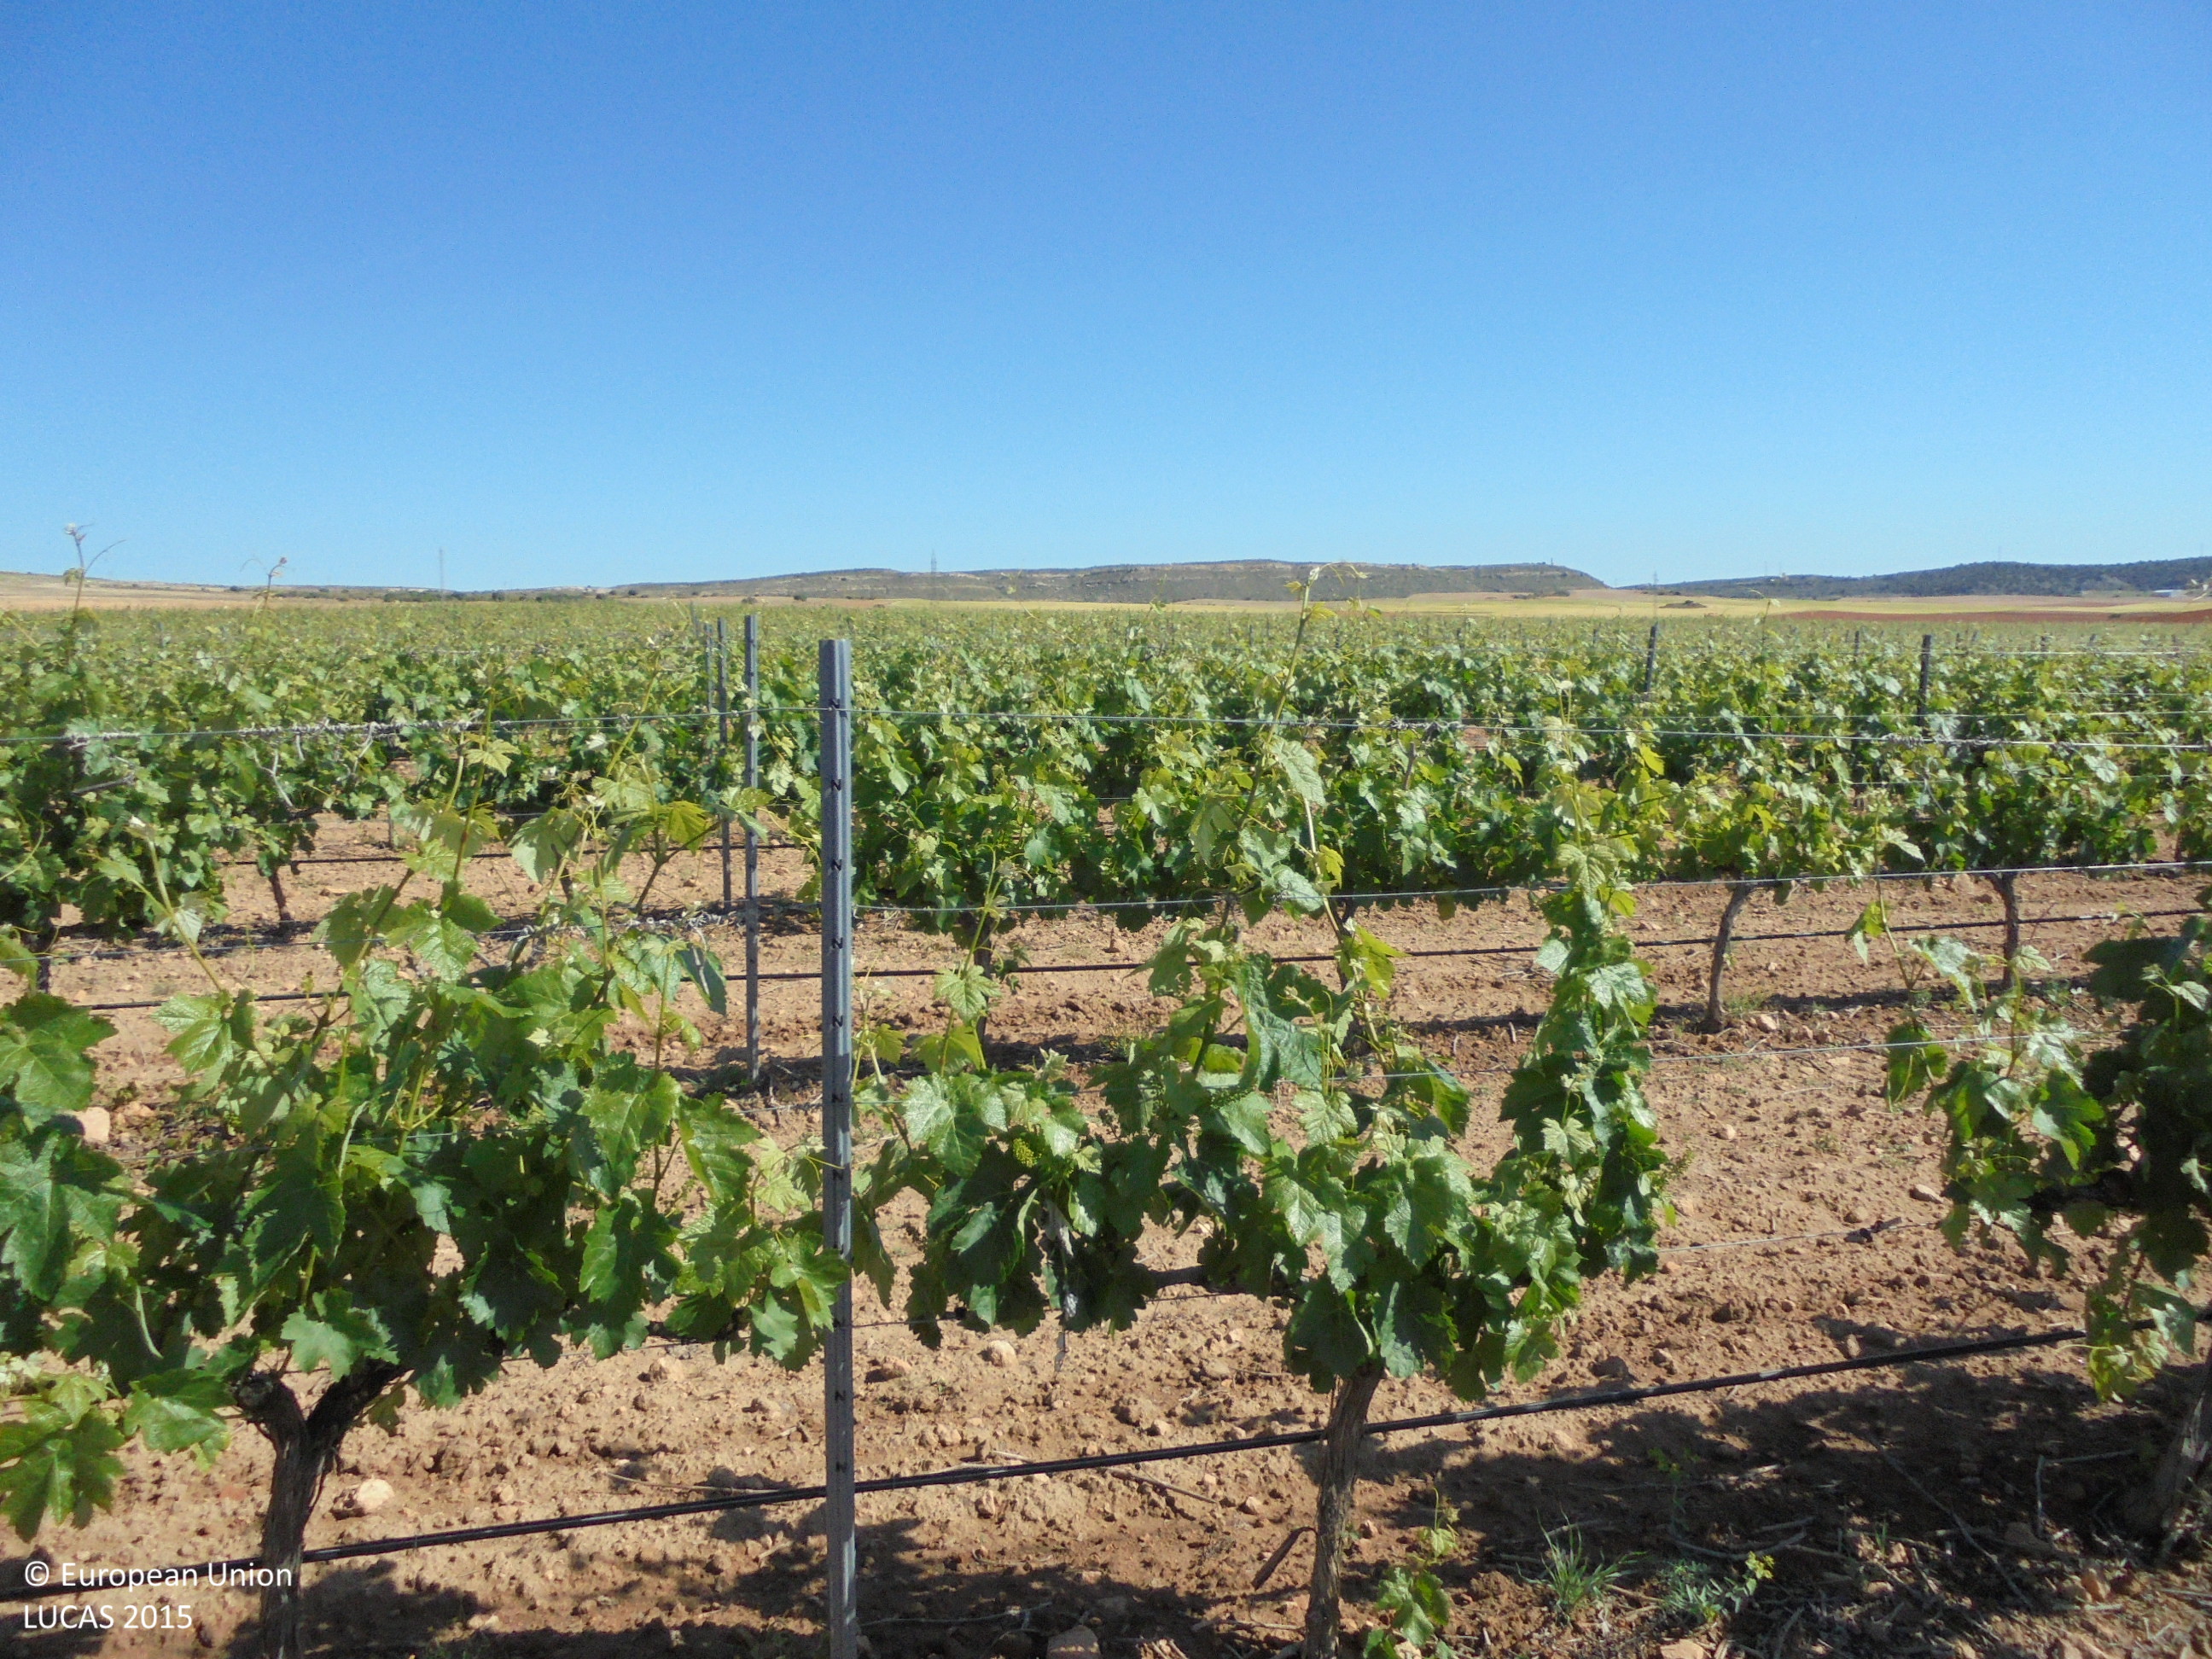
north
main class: Cropland
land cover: Vineyards
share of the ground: 25 - 50 %
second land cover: Other bare soil
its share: > 75 %
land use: Agriculture (excluding fallow land and kitchen gardens)
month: May
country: ES
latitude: 38.9094
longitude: -1.6801
